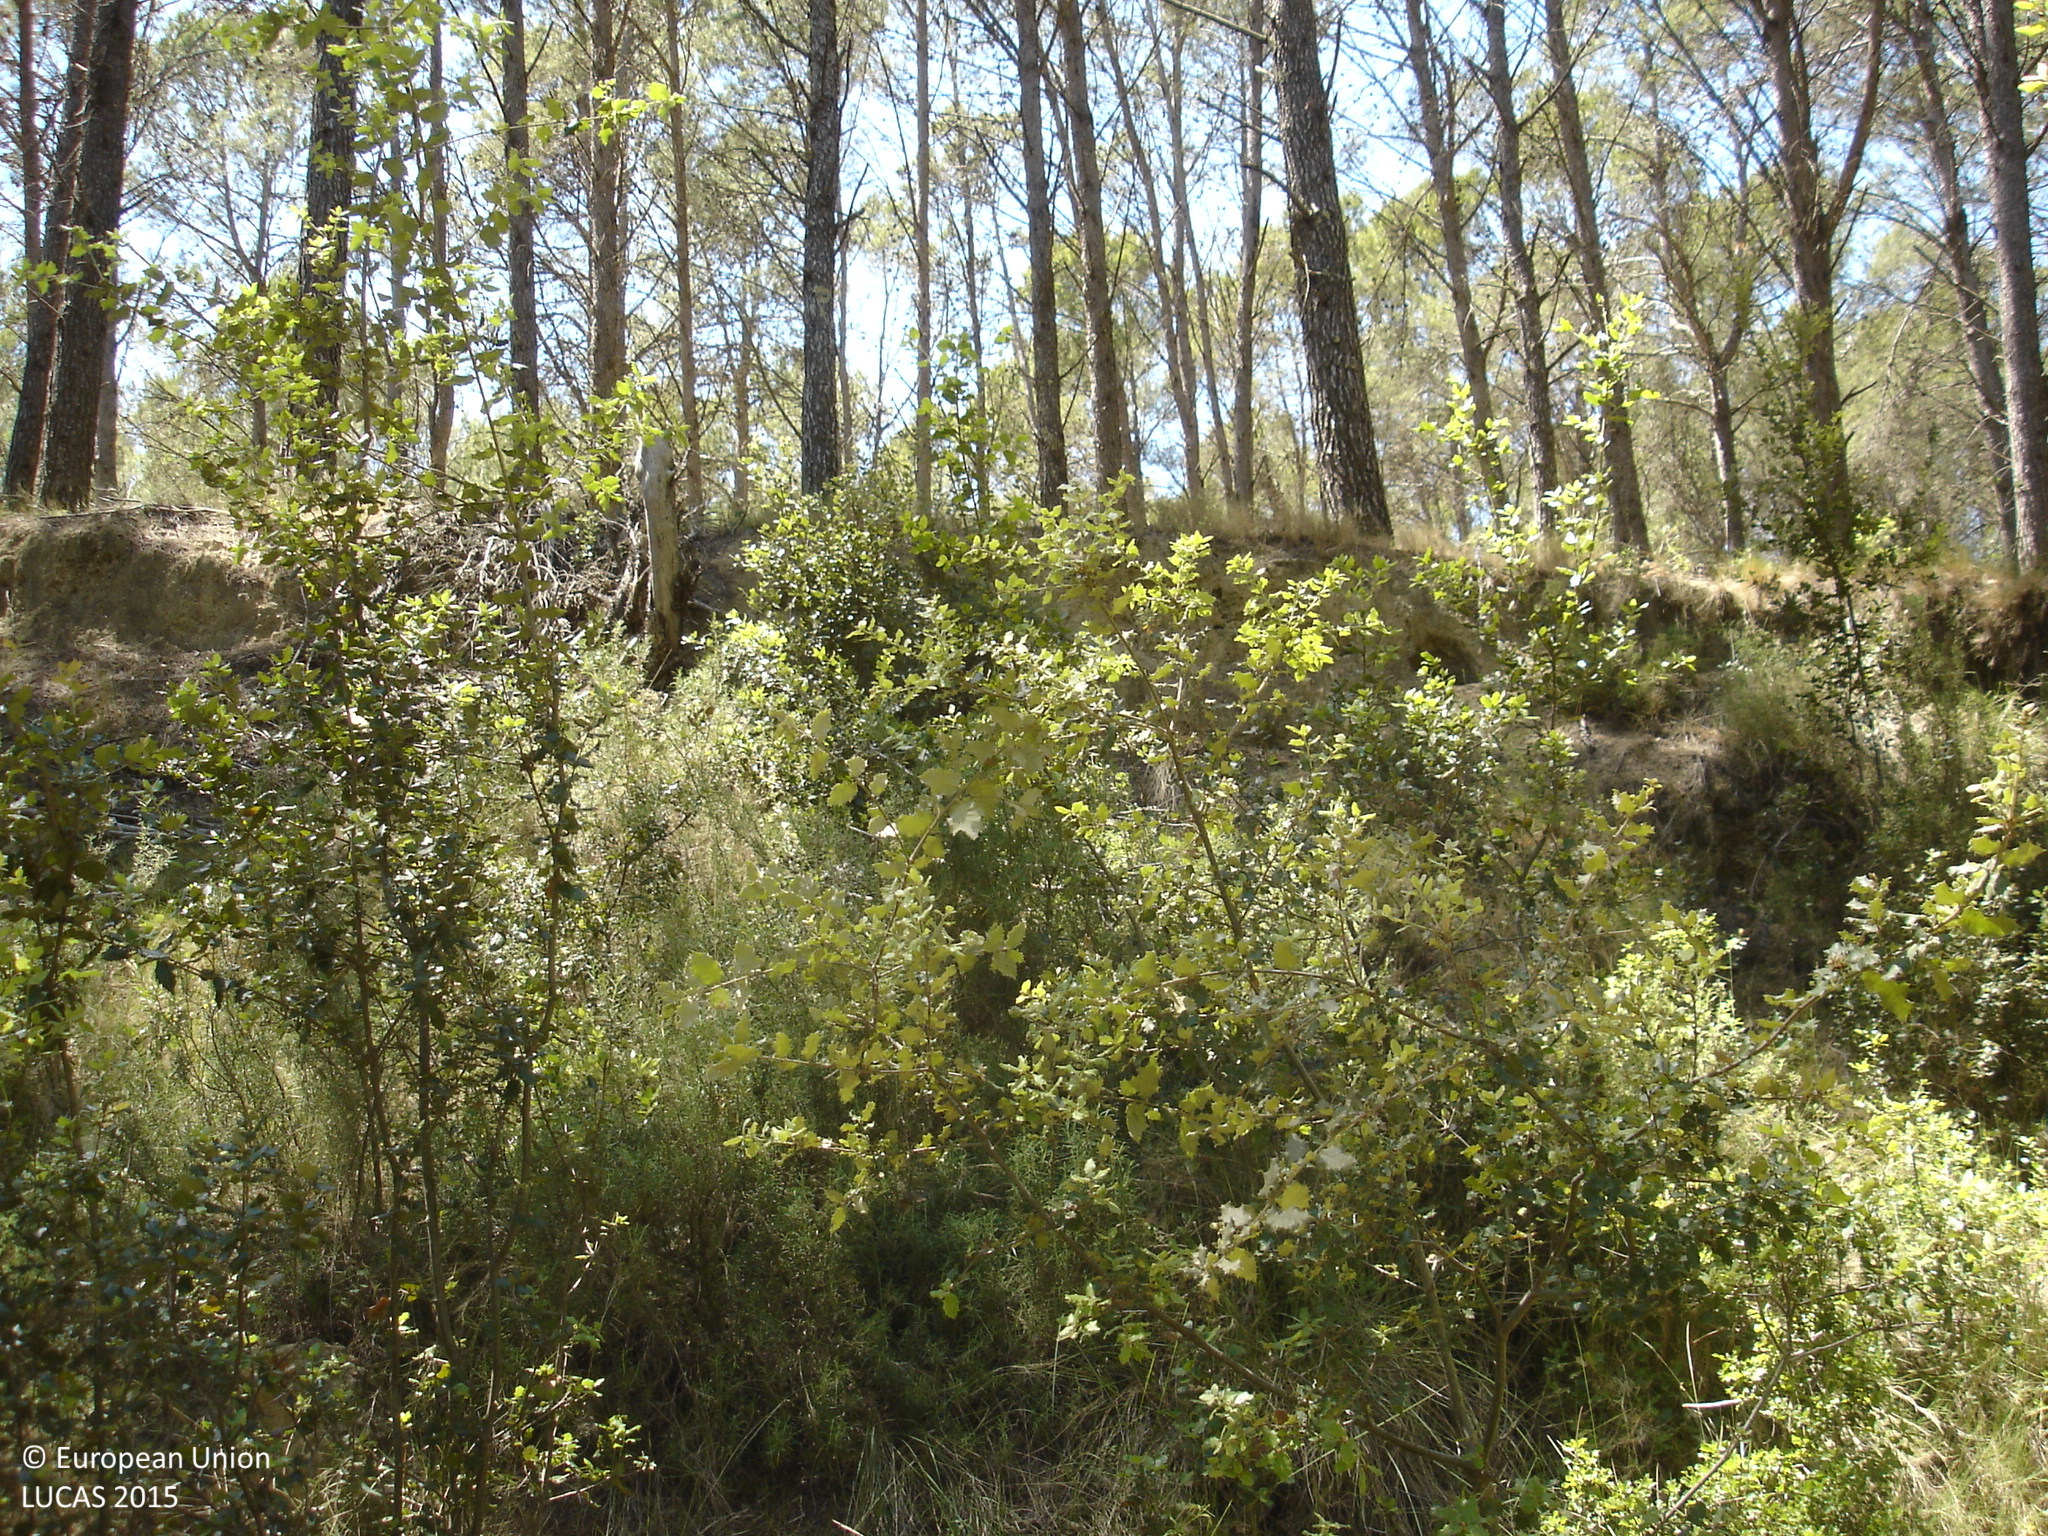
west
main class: Woodland
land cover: Pine dominated coniferous woodland
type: coniferous forest of the mediterranean region
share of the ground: > 75 %
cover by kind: coniferous forest trees 80 %, herbaceous plants 10 %, broadleaved forest trees 5 %, shrubs 5 %
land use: Forestry
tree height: > 5 m
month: May
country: ES
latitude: 42.0865
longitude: 3.0156
